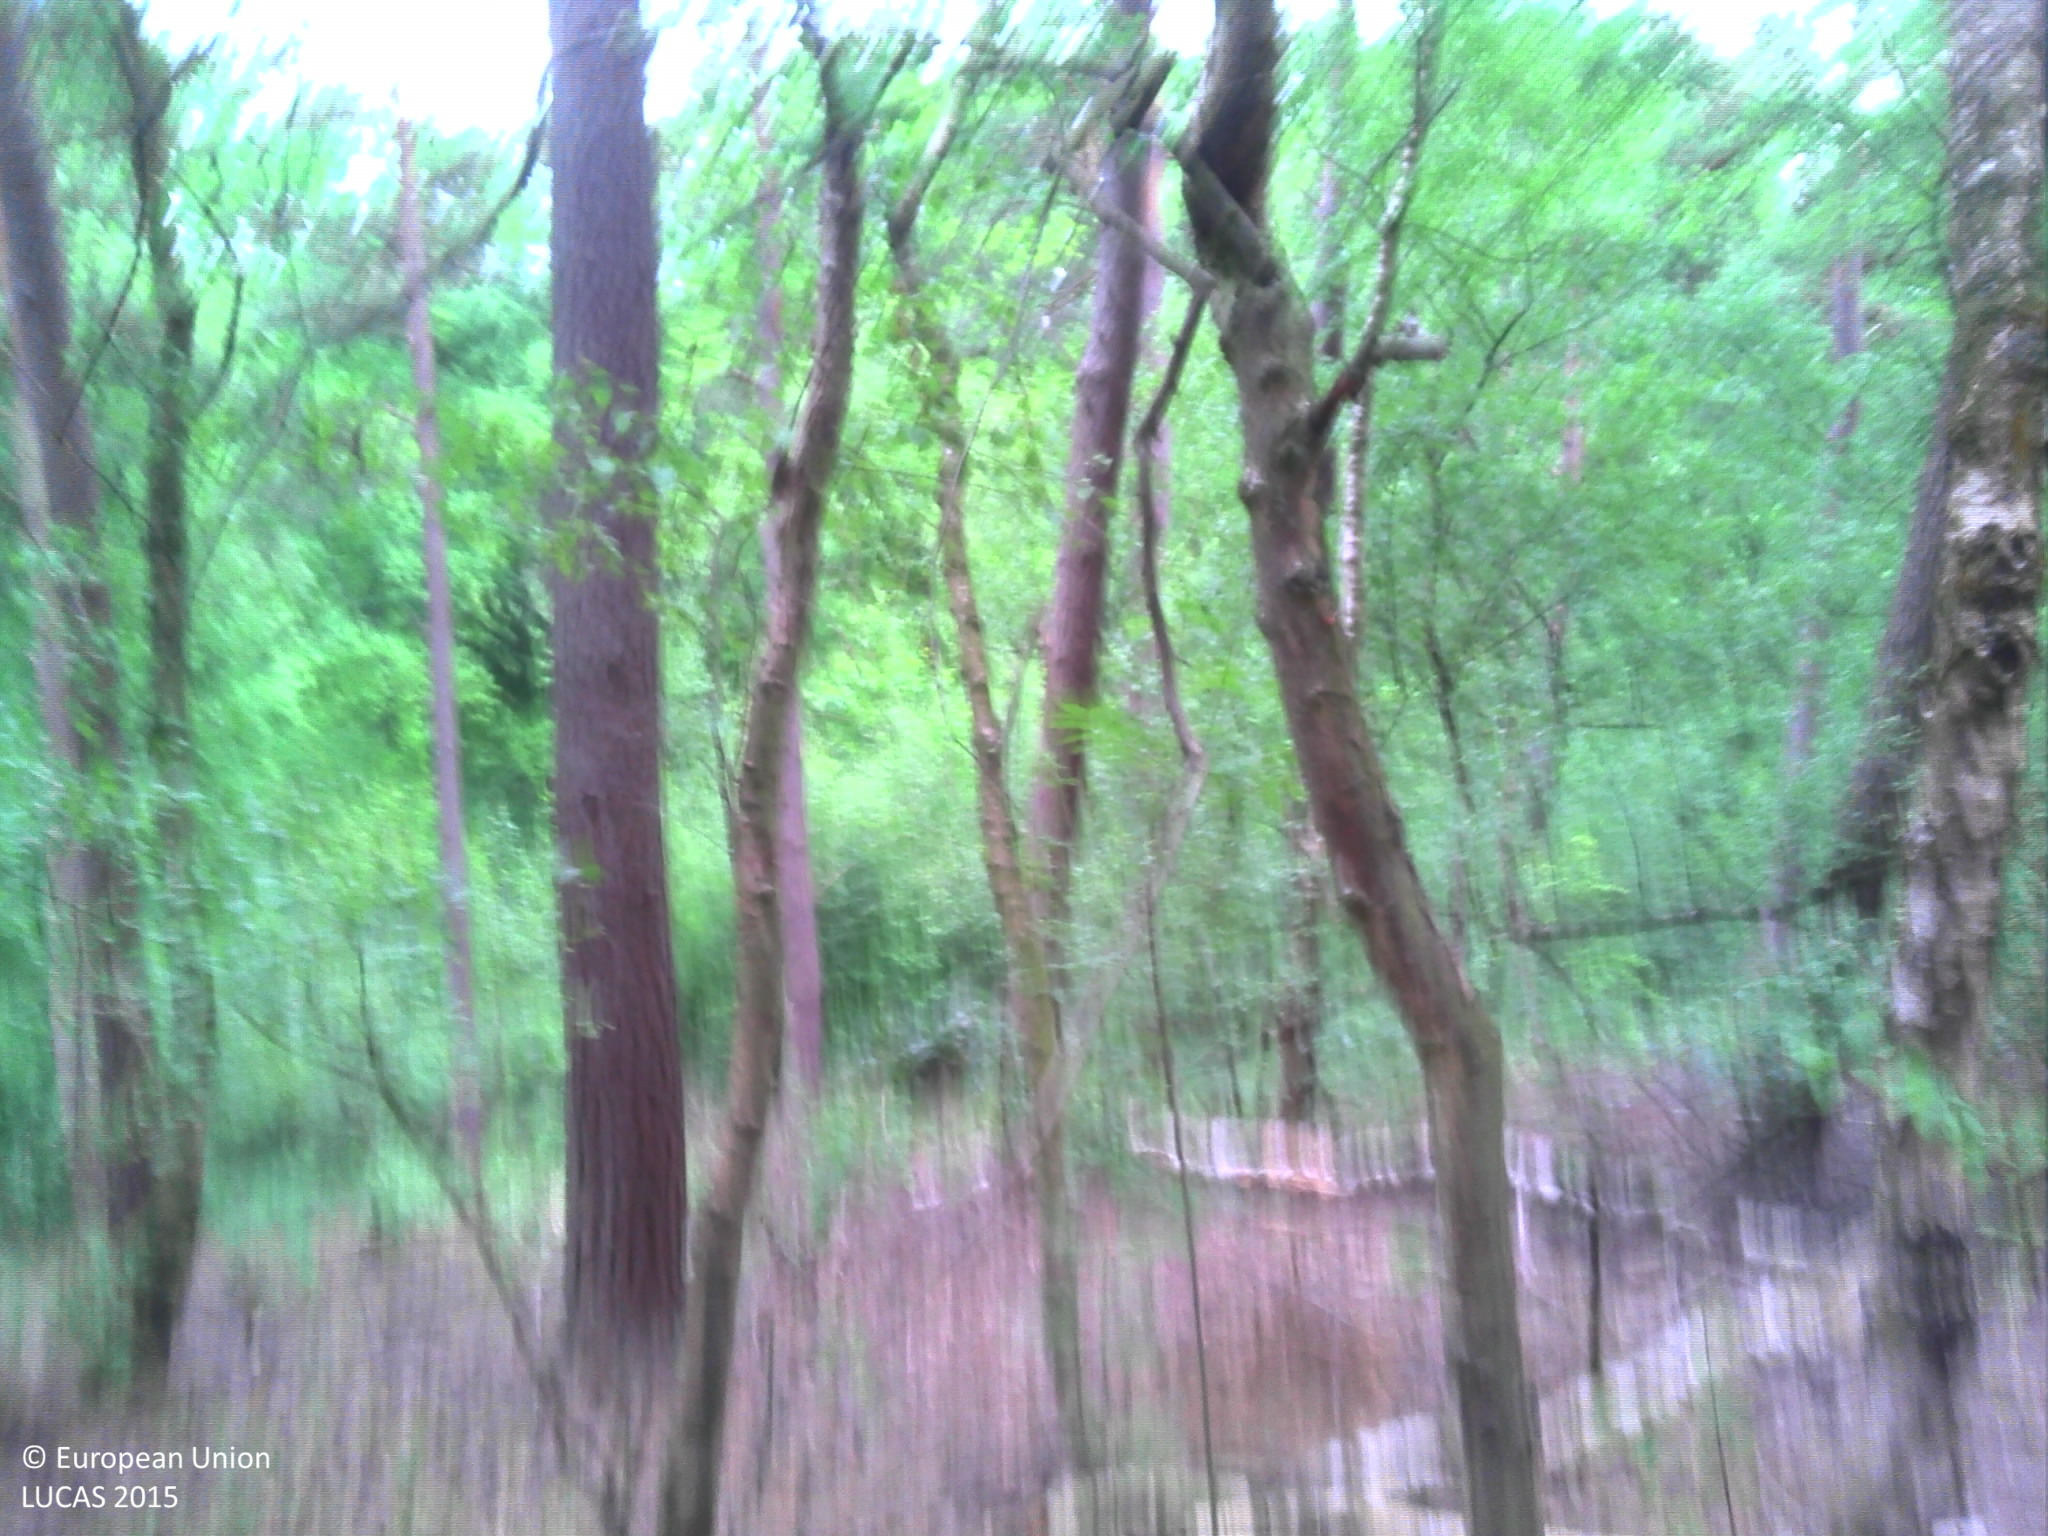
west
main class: Woodland
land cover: Pine dominated coniferous woodland
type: exotic forest
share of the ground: > 75 %
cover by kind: coniferous forest trees 100 %
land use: Forestry
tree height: > 5 m
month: May
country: BE
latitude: 50.7204
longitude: 4.5426
